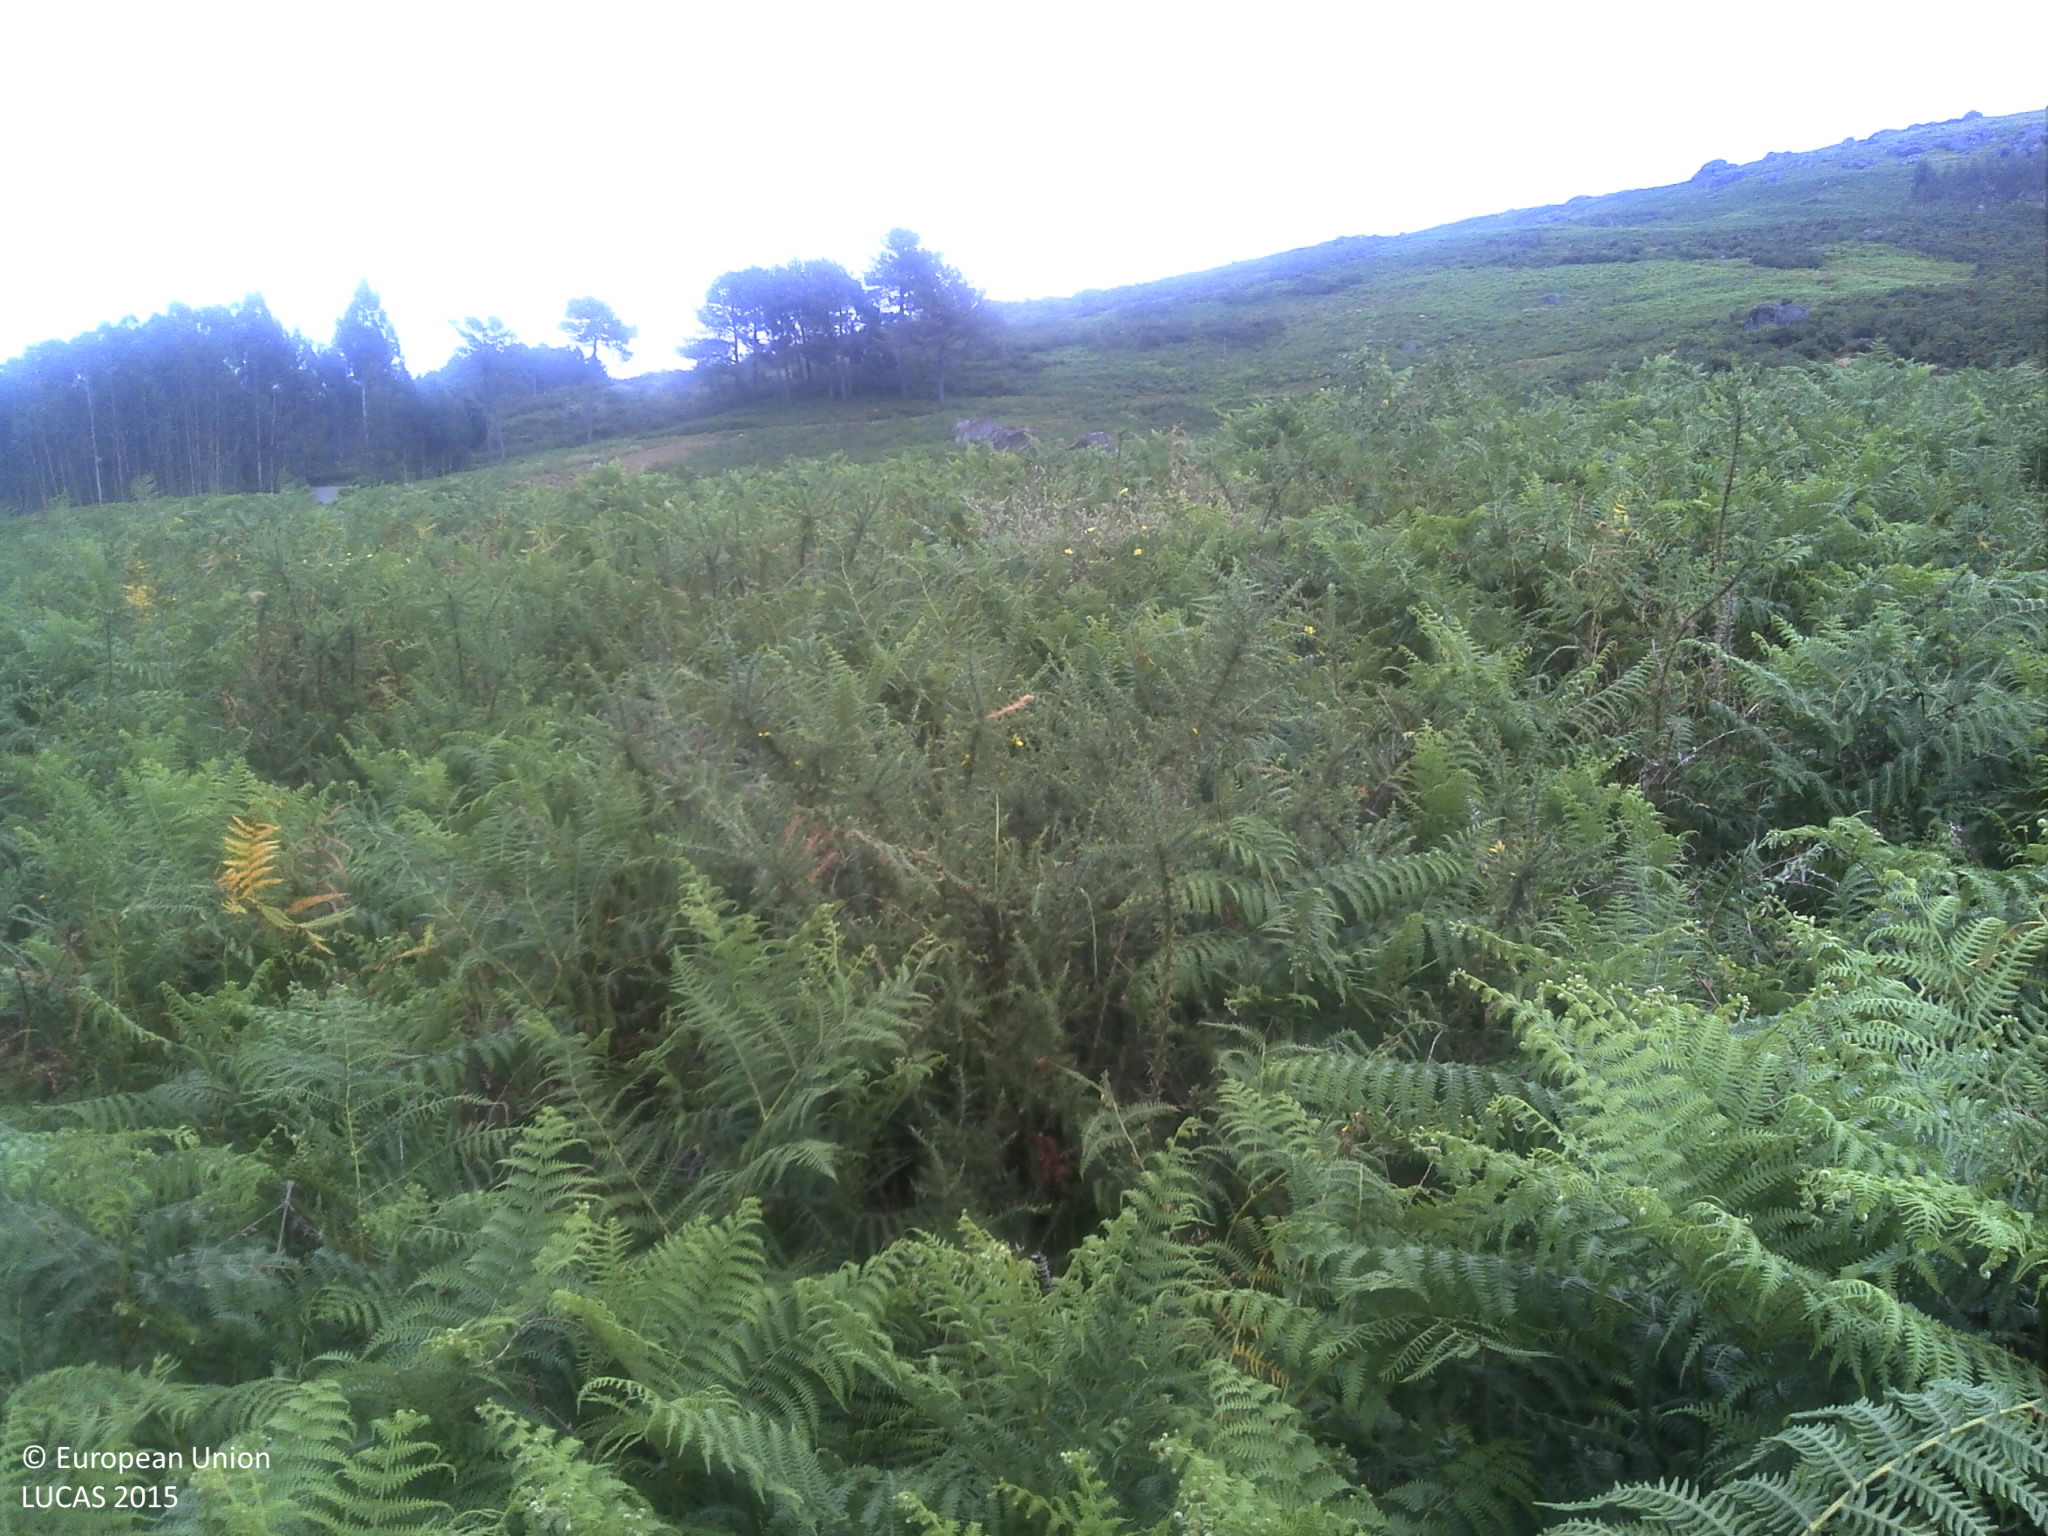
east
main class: Shrubland
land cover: Shrubland without tree cover
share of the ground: > 75 %
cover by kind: shrubs 90 %, herbaceous plants 10 %
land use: Semi-natural and natural areas not in use
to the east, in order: Shrubland without tree cover; Tracks; Shrubland without tree cover; Paved roads, cycling and walking lanes; Shrubland without tree cover; Paved roads, cycling and walking lanes; Shrubland without tree cover; Broadleaved woodland
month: June
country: PT
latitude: 41.7109
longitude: -8.3875
